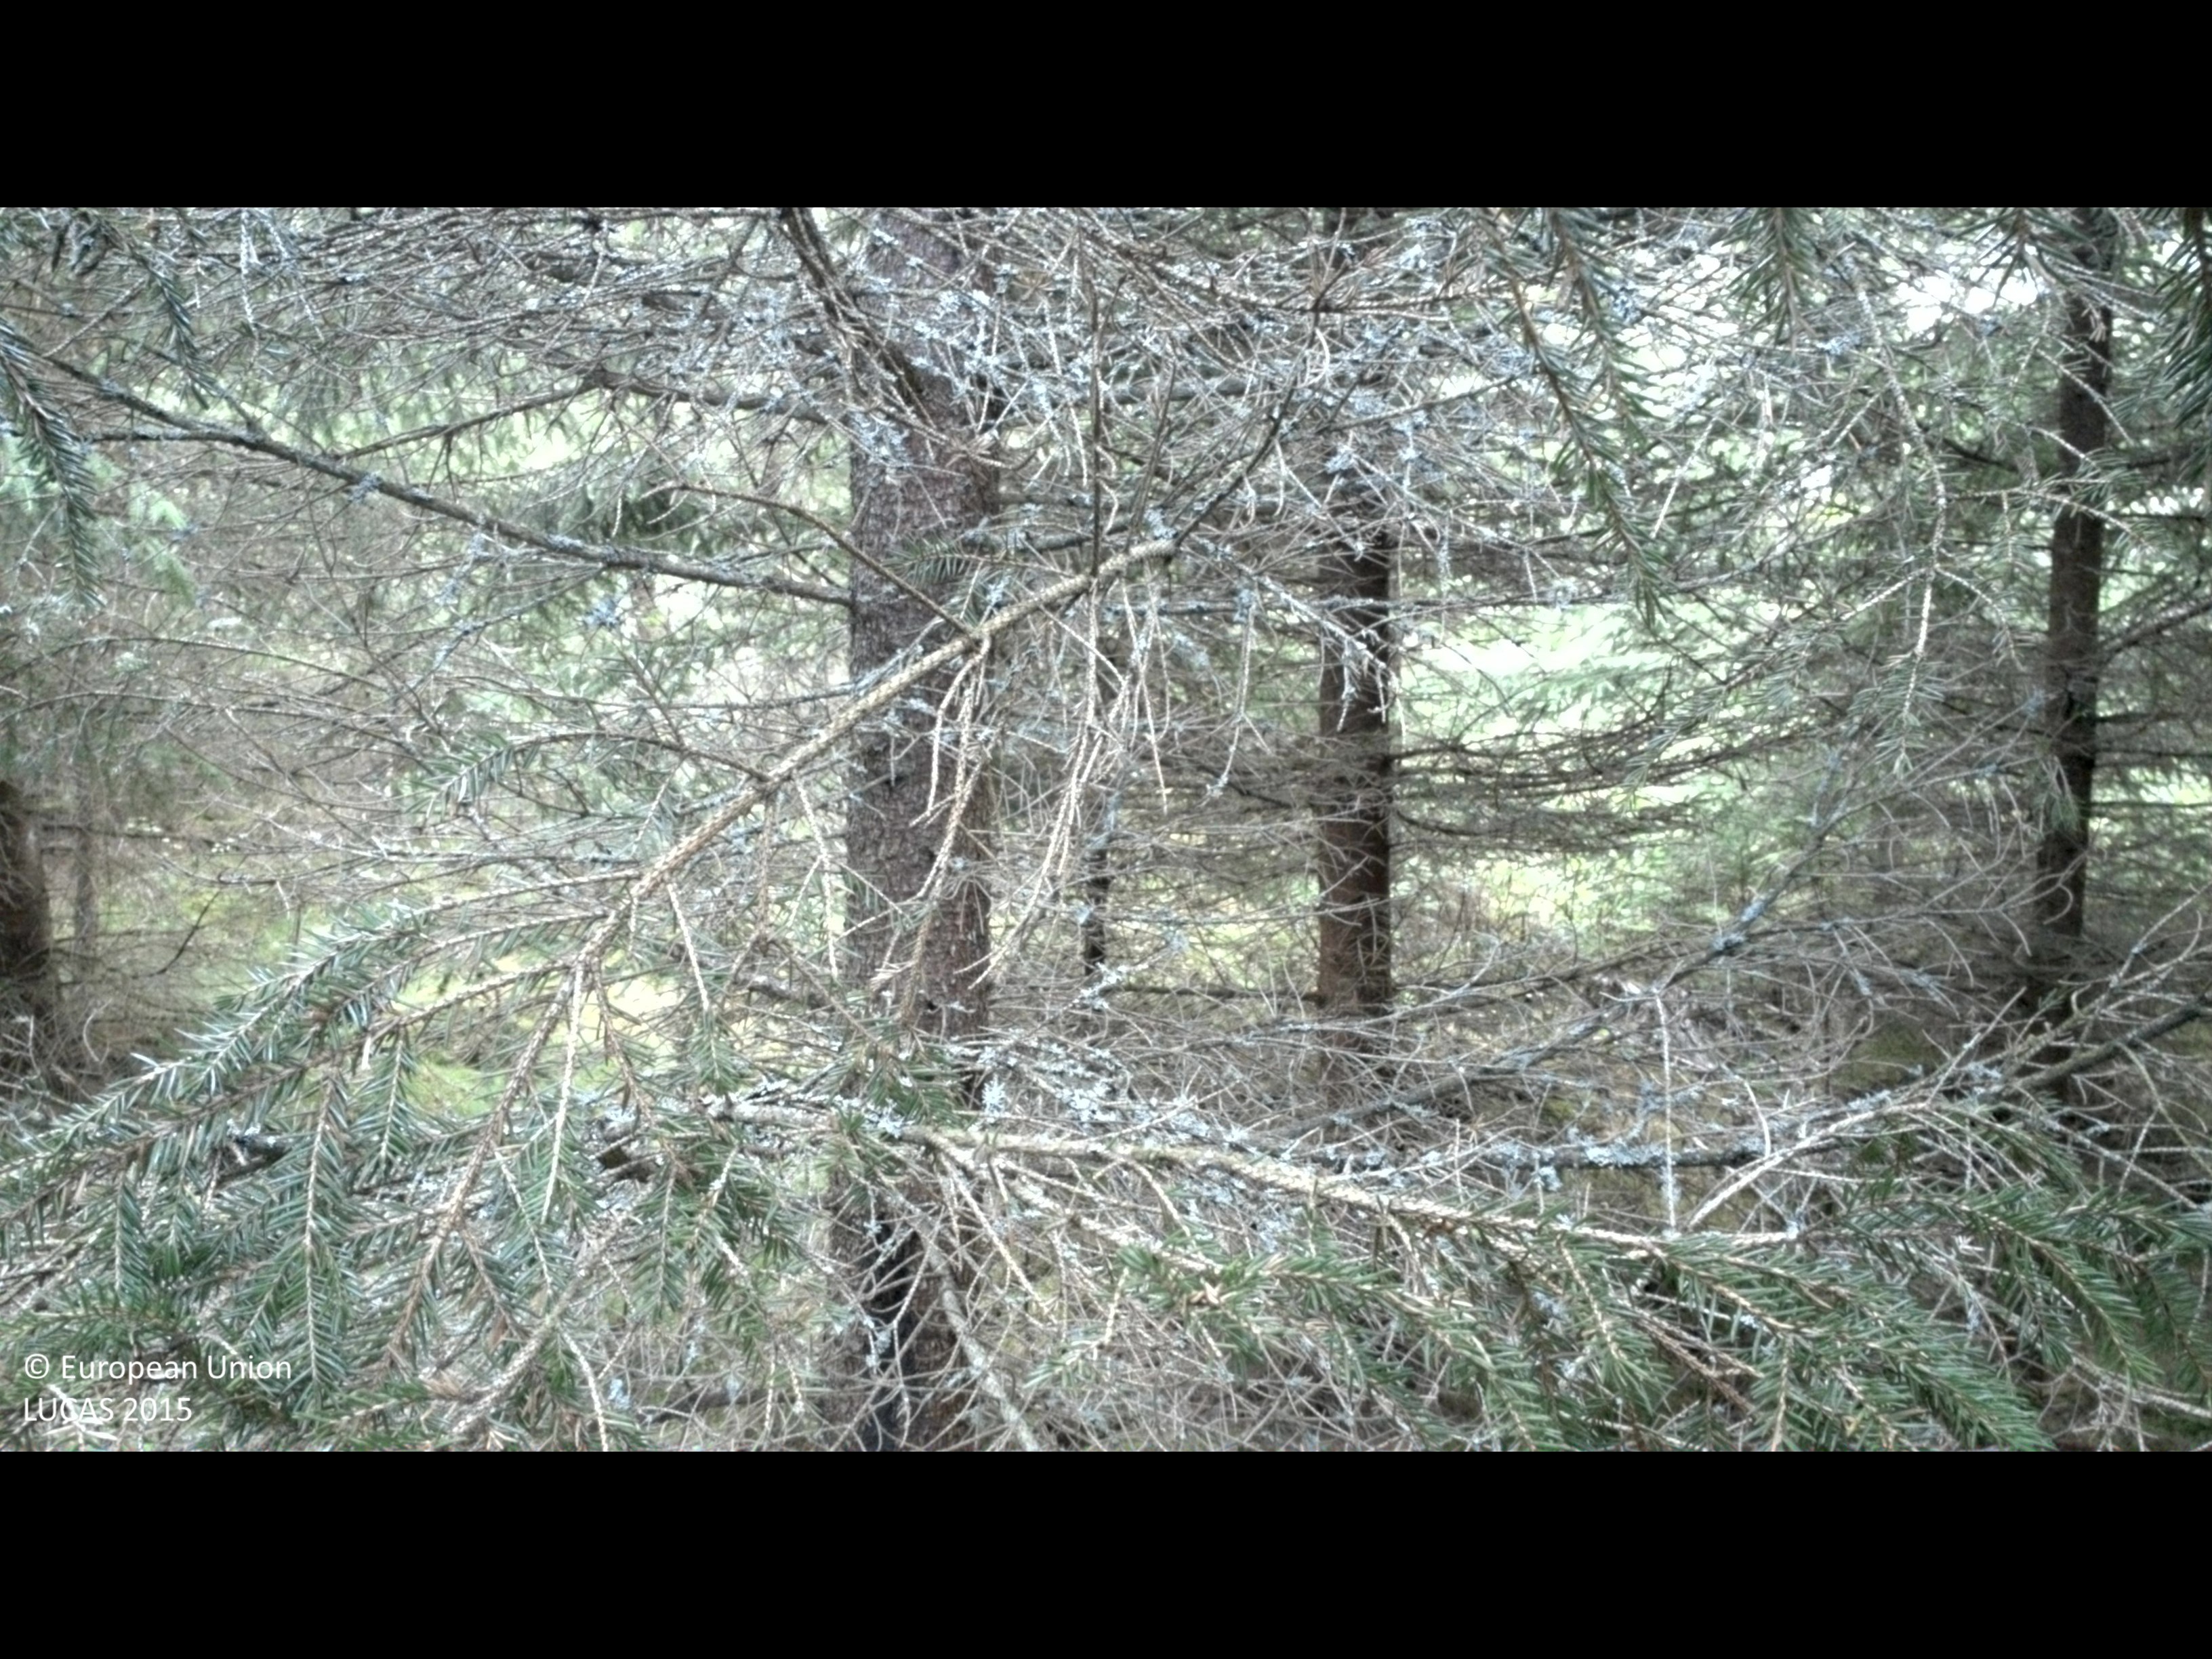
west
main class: Woodland
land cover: Spruce dominated mixed woodland
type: boreal forest
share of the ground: > 75 %
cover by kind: coniferous forest trees 60 %, broadleaved forest trees 20 %, shrubs 20 %
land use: Forestry
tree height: > 5 m
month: July
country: SE
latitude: 56.4911
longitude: 13.8138
